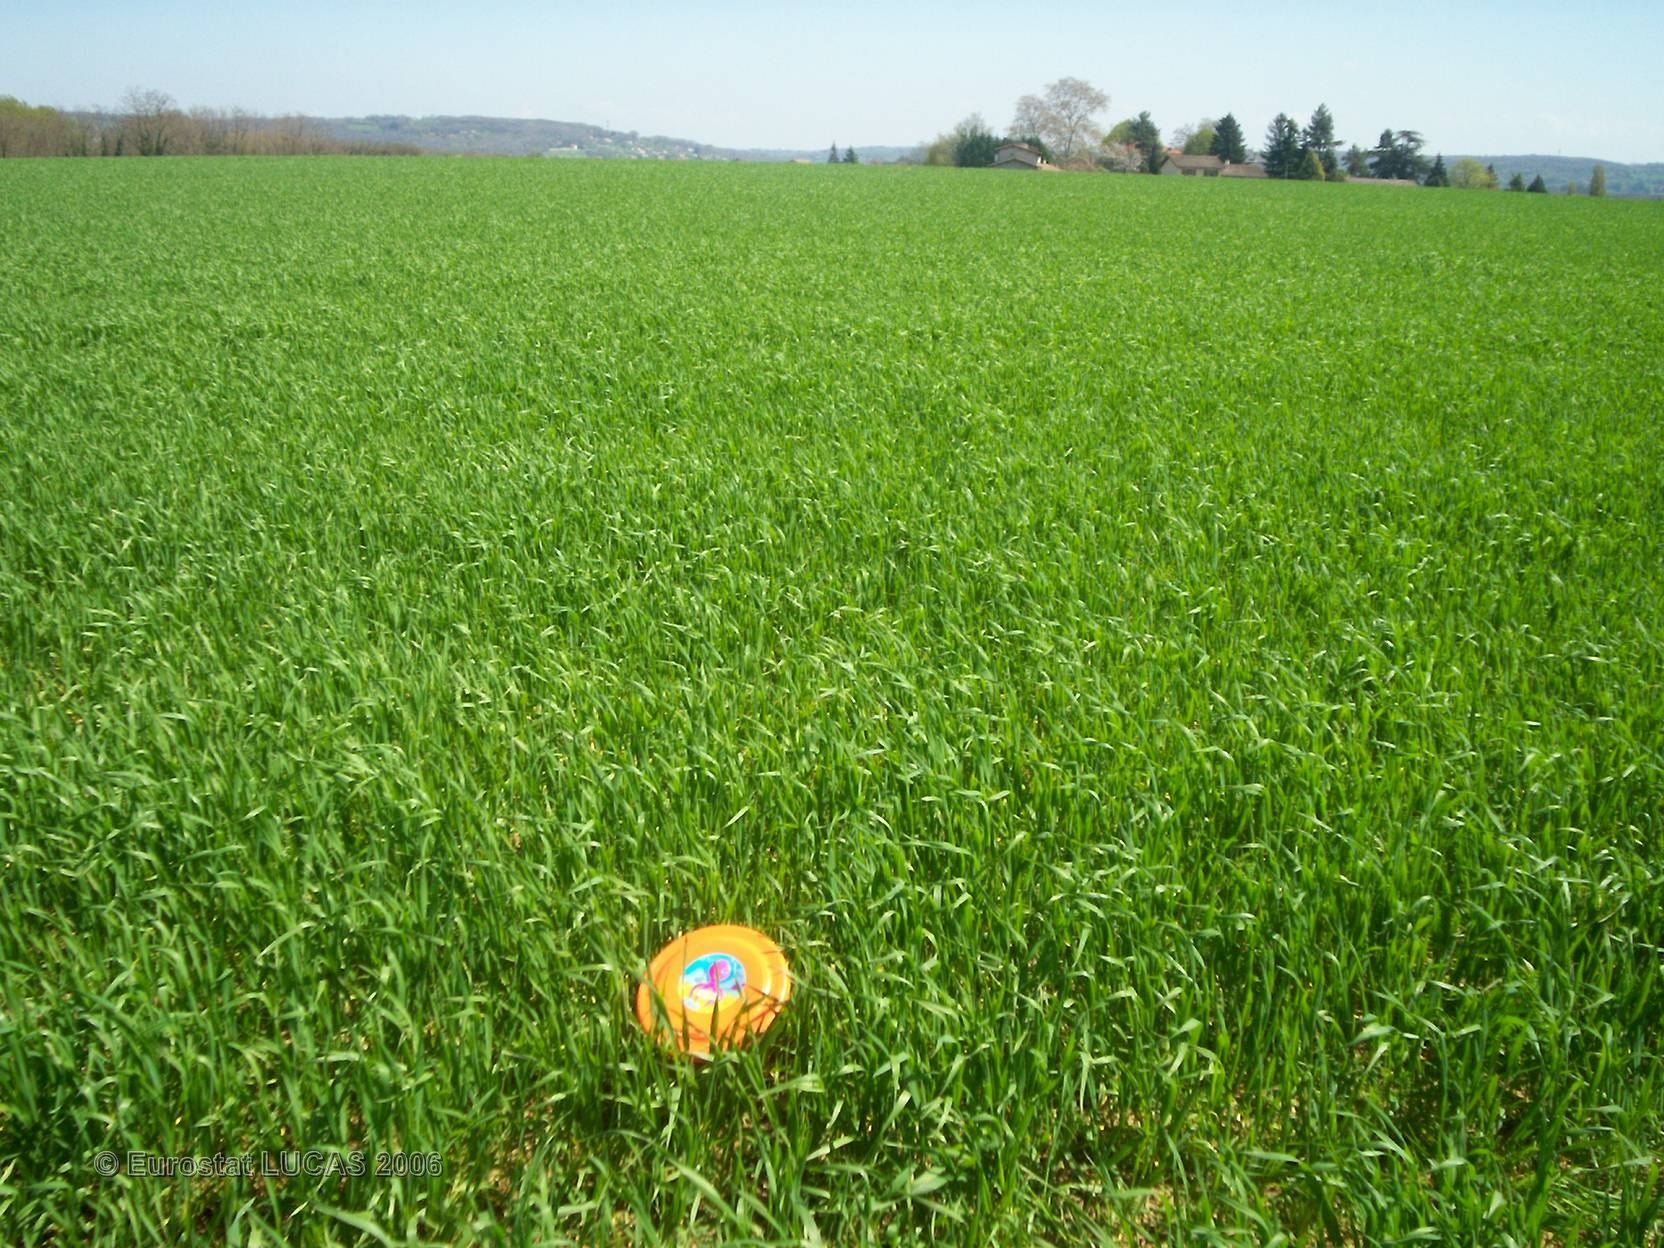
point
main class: Cropland
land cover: Common wheat
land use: Agriculture (excluding fallow land and kitchen gardens)
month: April
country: FR
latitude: 45.4318
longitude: 4.8276
